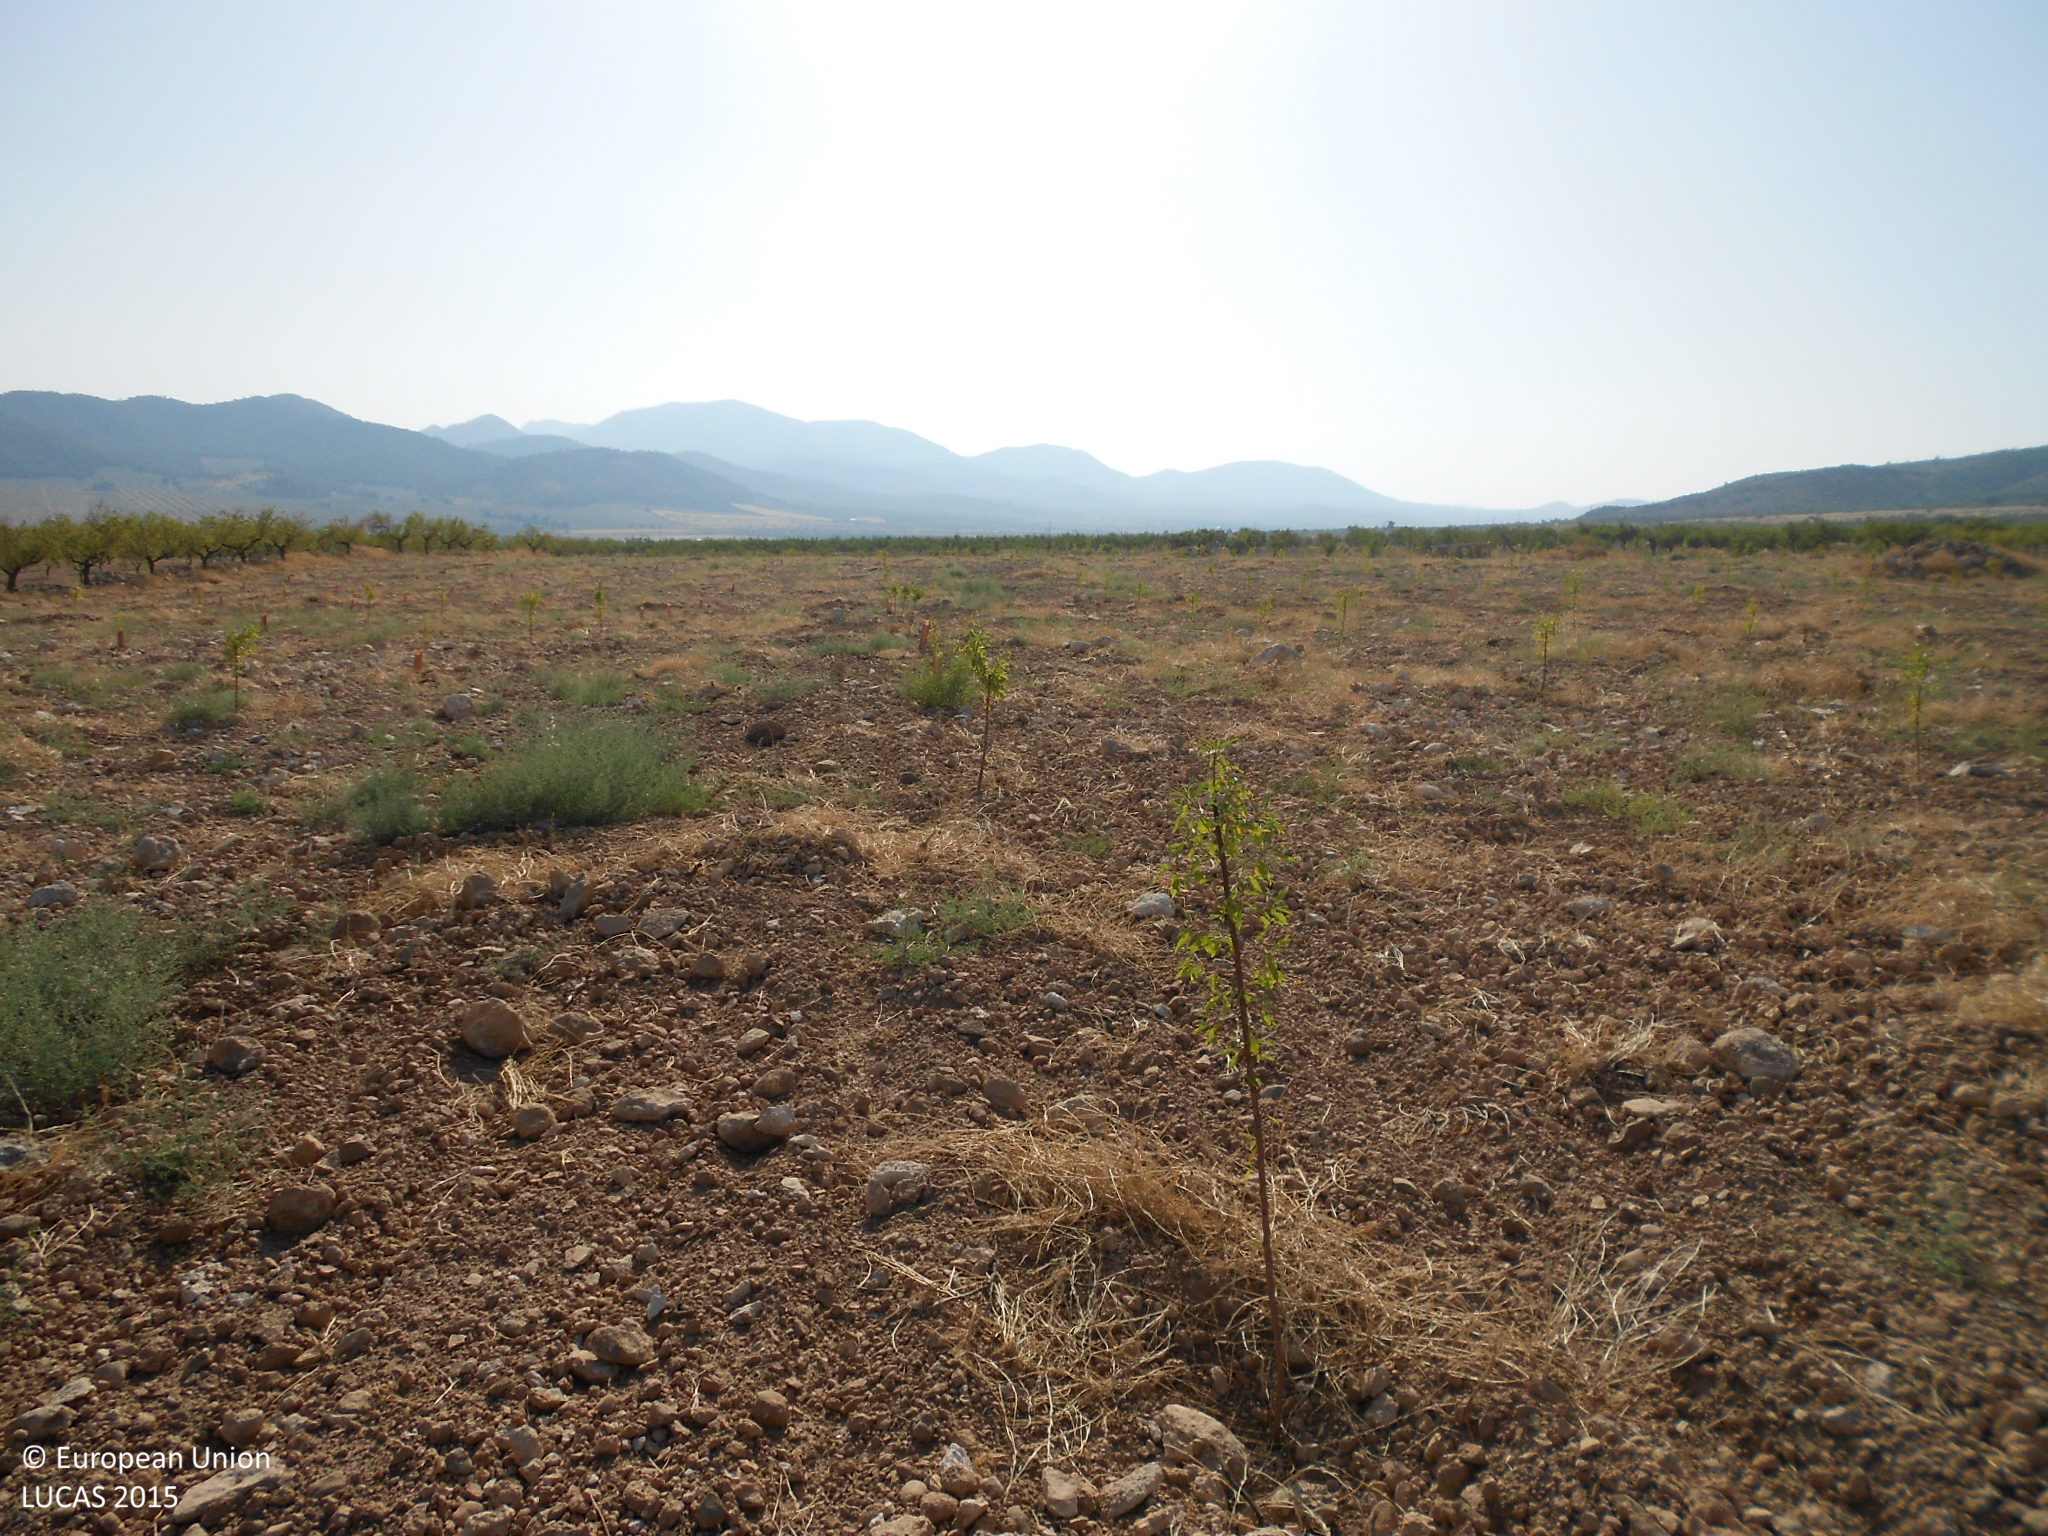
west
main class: Cropland
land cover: Nuts trees
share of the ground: < 10 %
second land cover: Other bare soil
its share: > 75 %
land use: Agriculture (excluding fallow land and kitchen gardens)
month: July
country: ES
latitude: 37.4716
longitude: -2.3425
